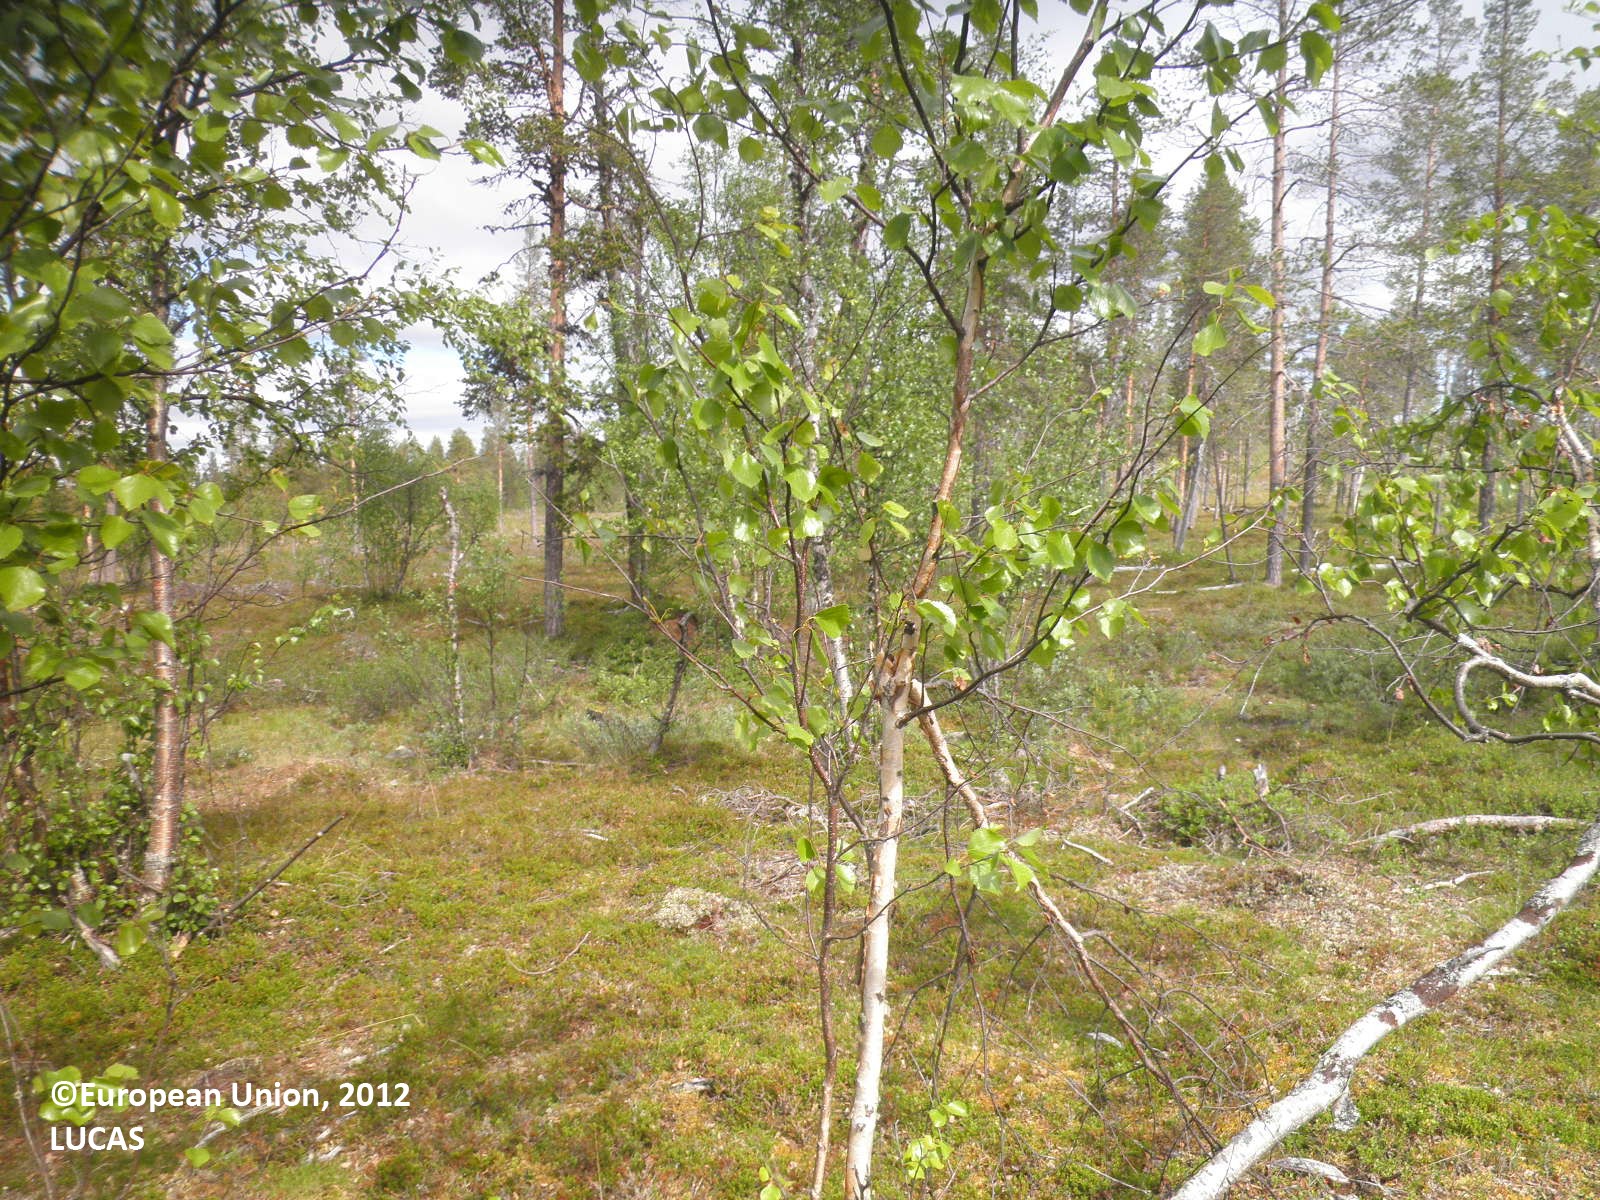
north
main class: Woodland
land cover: Pine dominated mixed woodland
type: boreal forest
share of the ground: 25 - 50 %
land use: Forestry
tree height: > 5 m
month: July
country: FI
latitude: 68.6567
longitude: 26.3216
